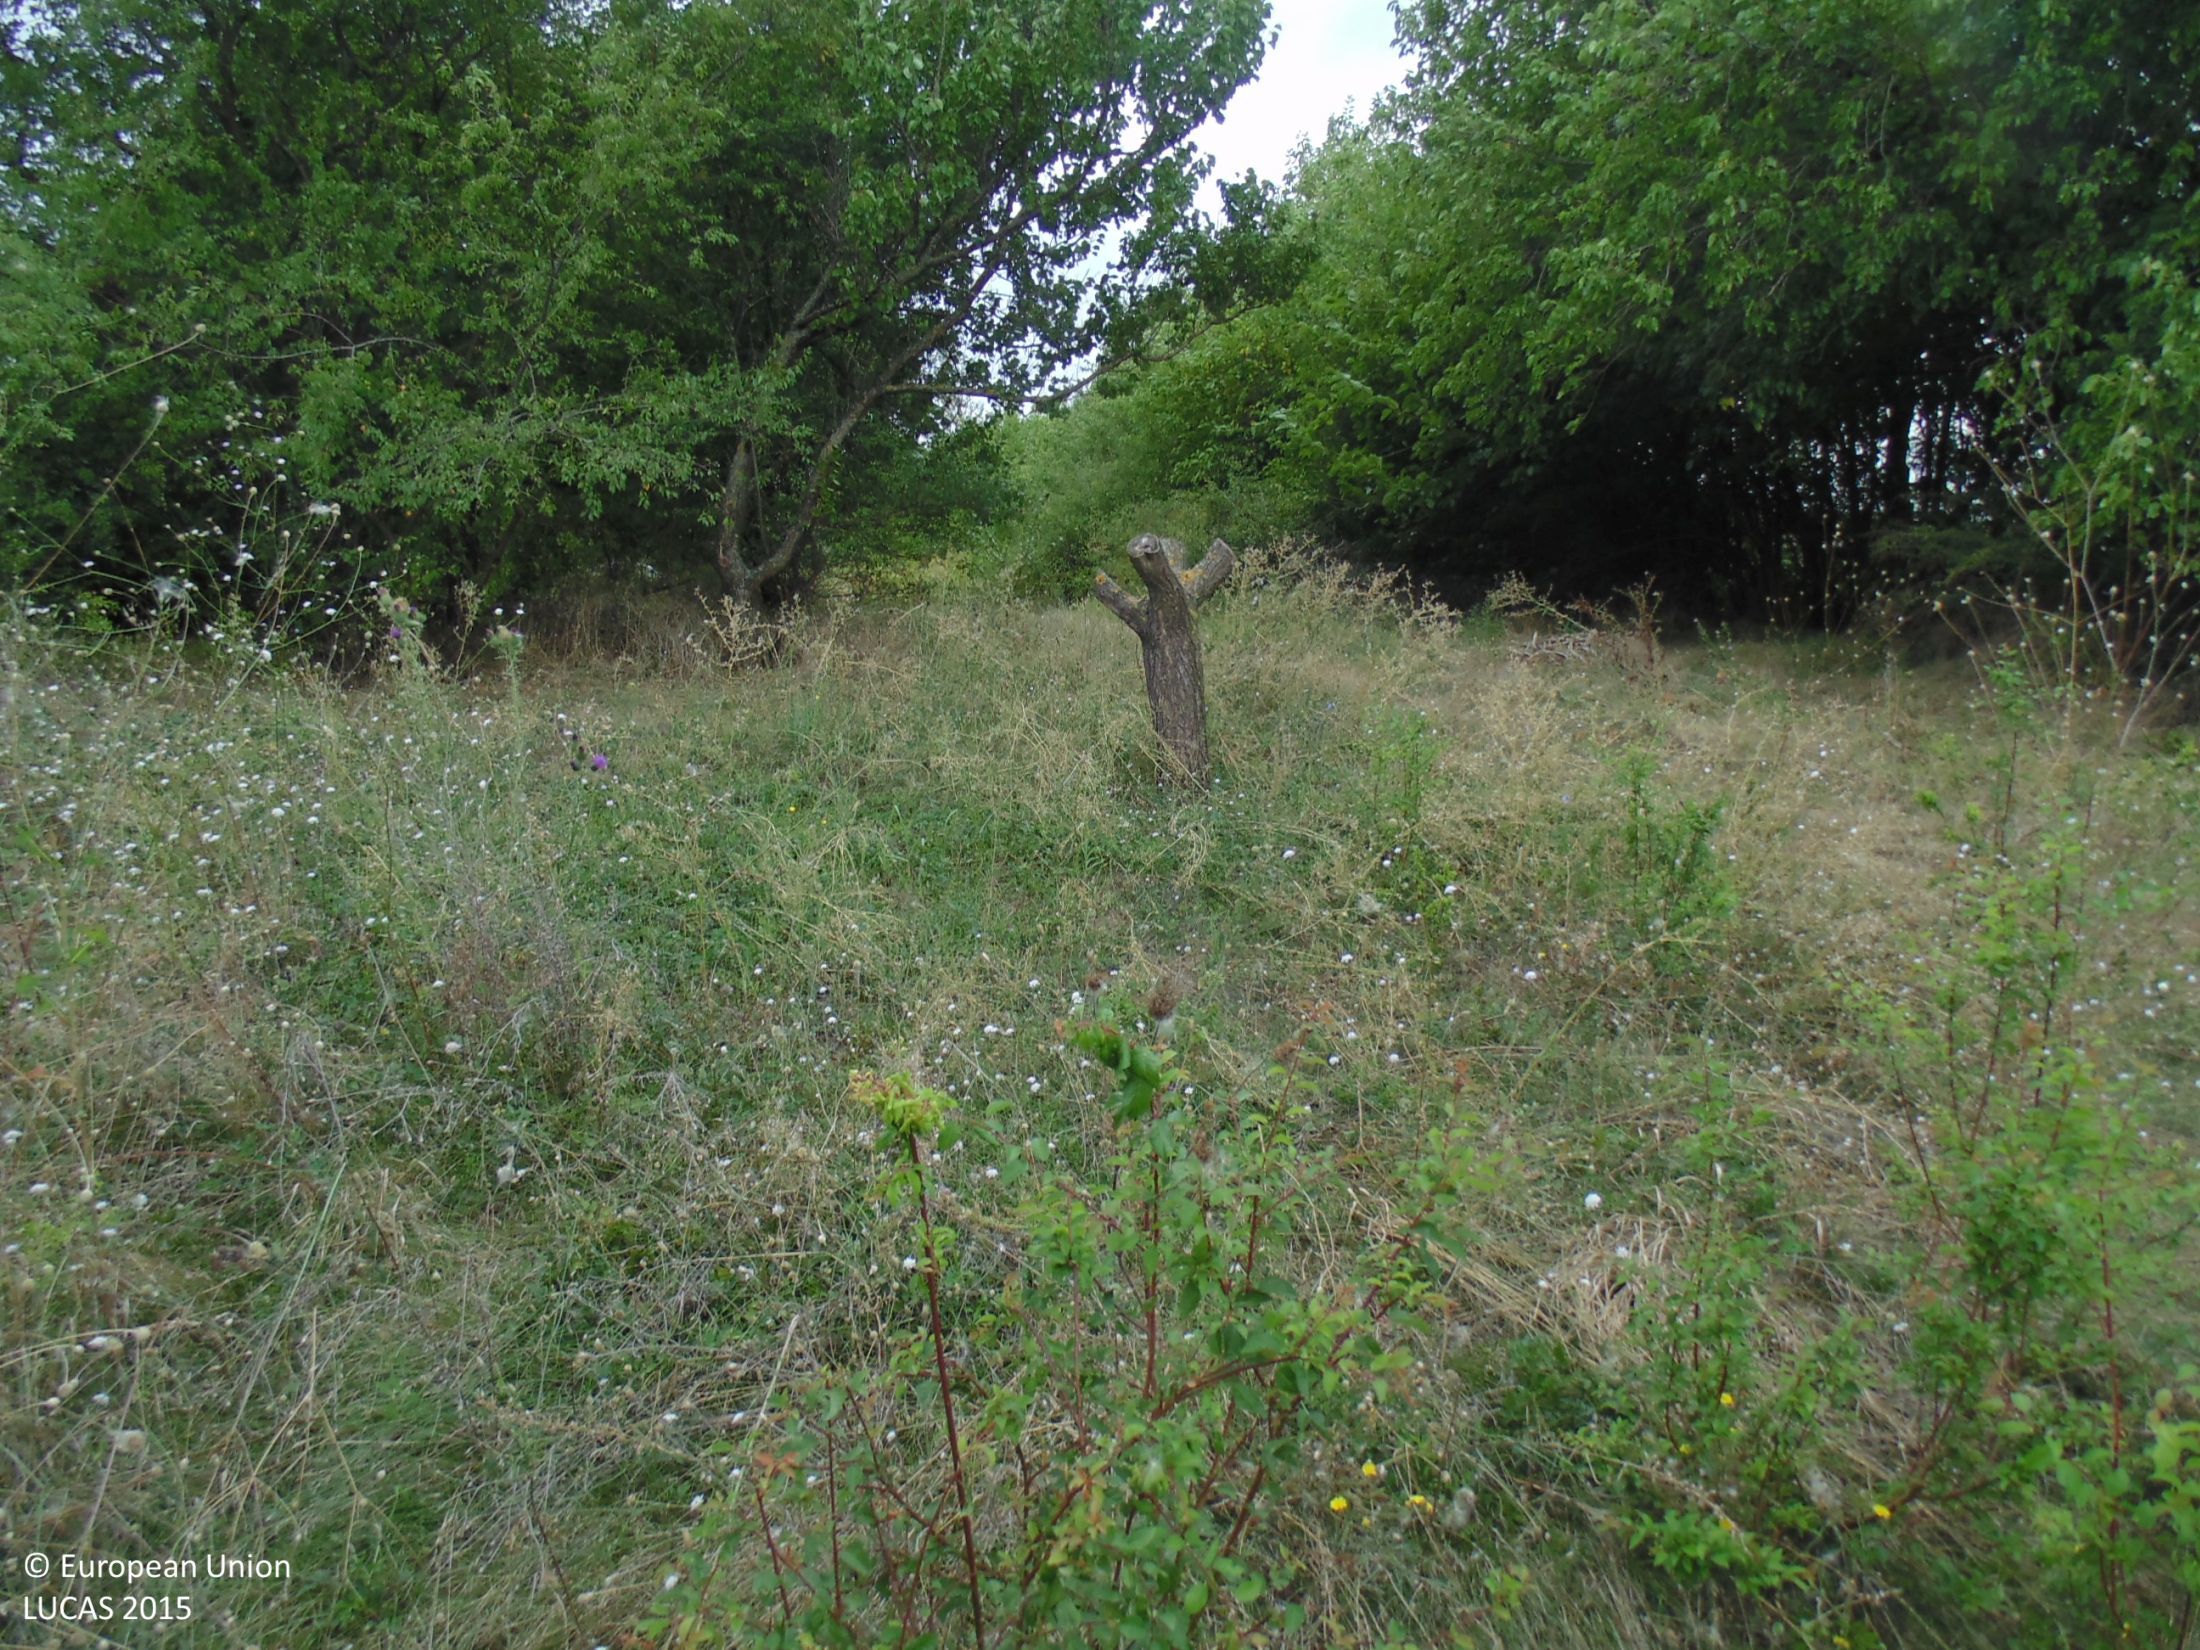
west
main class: Cropland
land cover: Other fruit trees and berries
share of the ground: 50 - 75 %
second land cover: Grassland without tree/shrub cover
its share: > 75 %
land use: Agriculture (excluding fallow land and kitchen gardens)
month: September
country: BG
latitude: 44.0164
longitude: 27.0269
